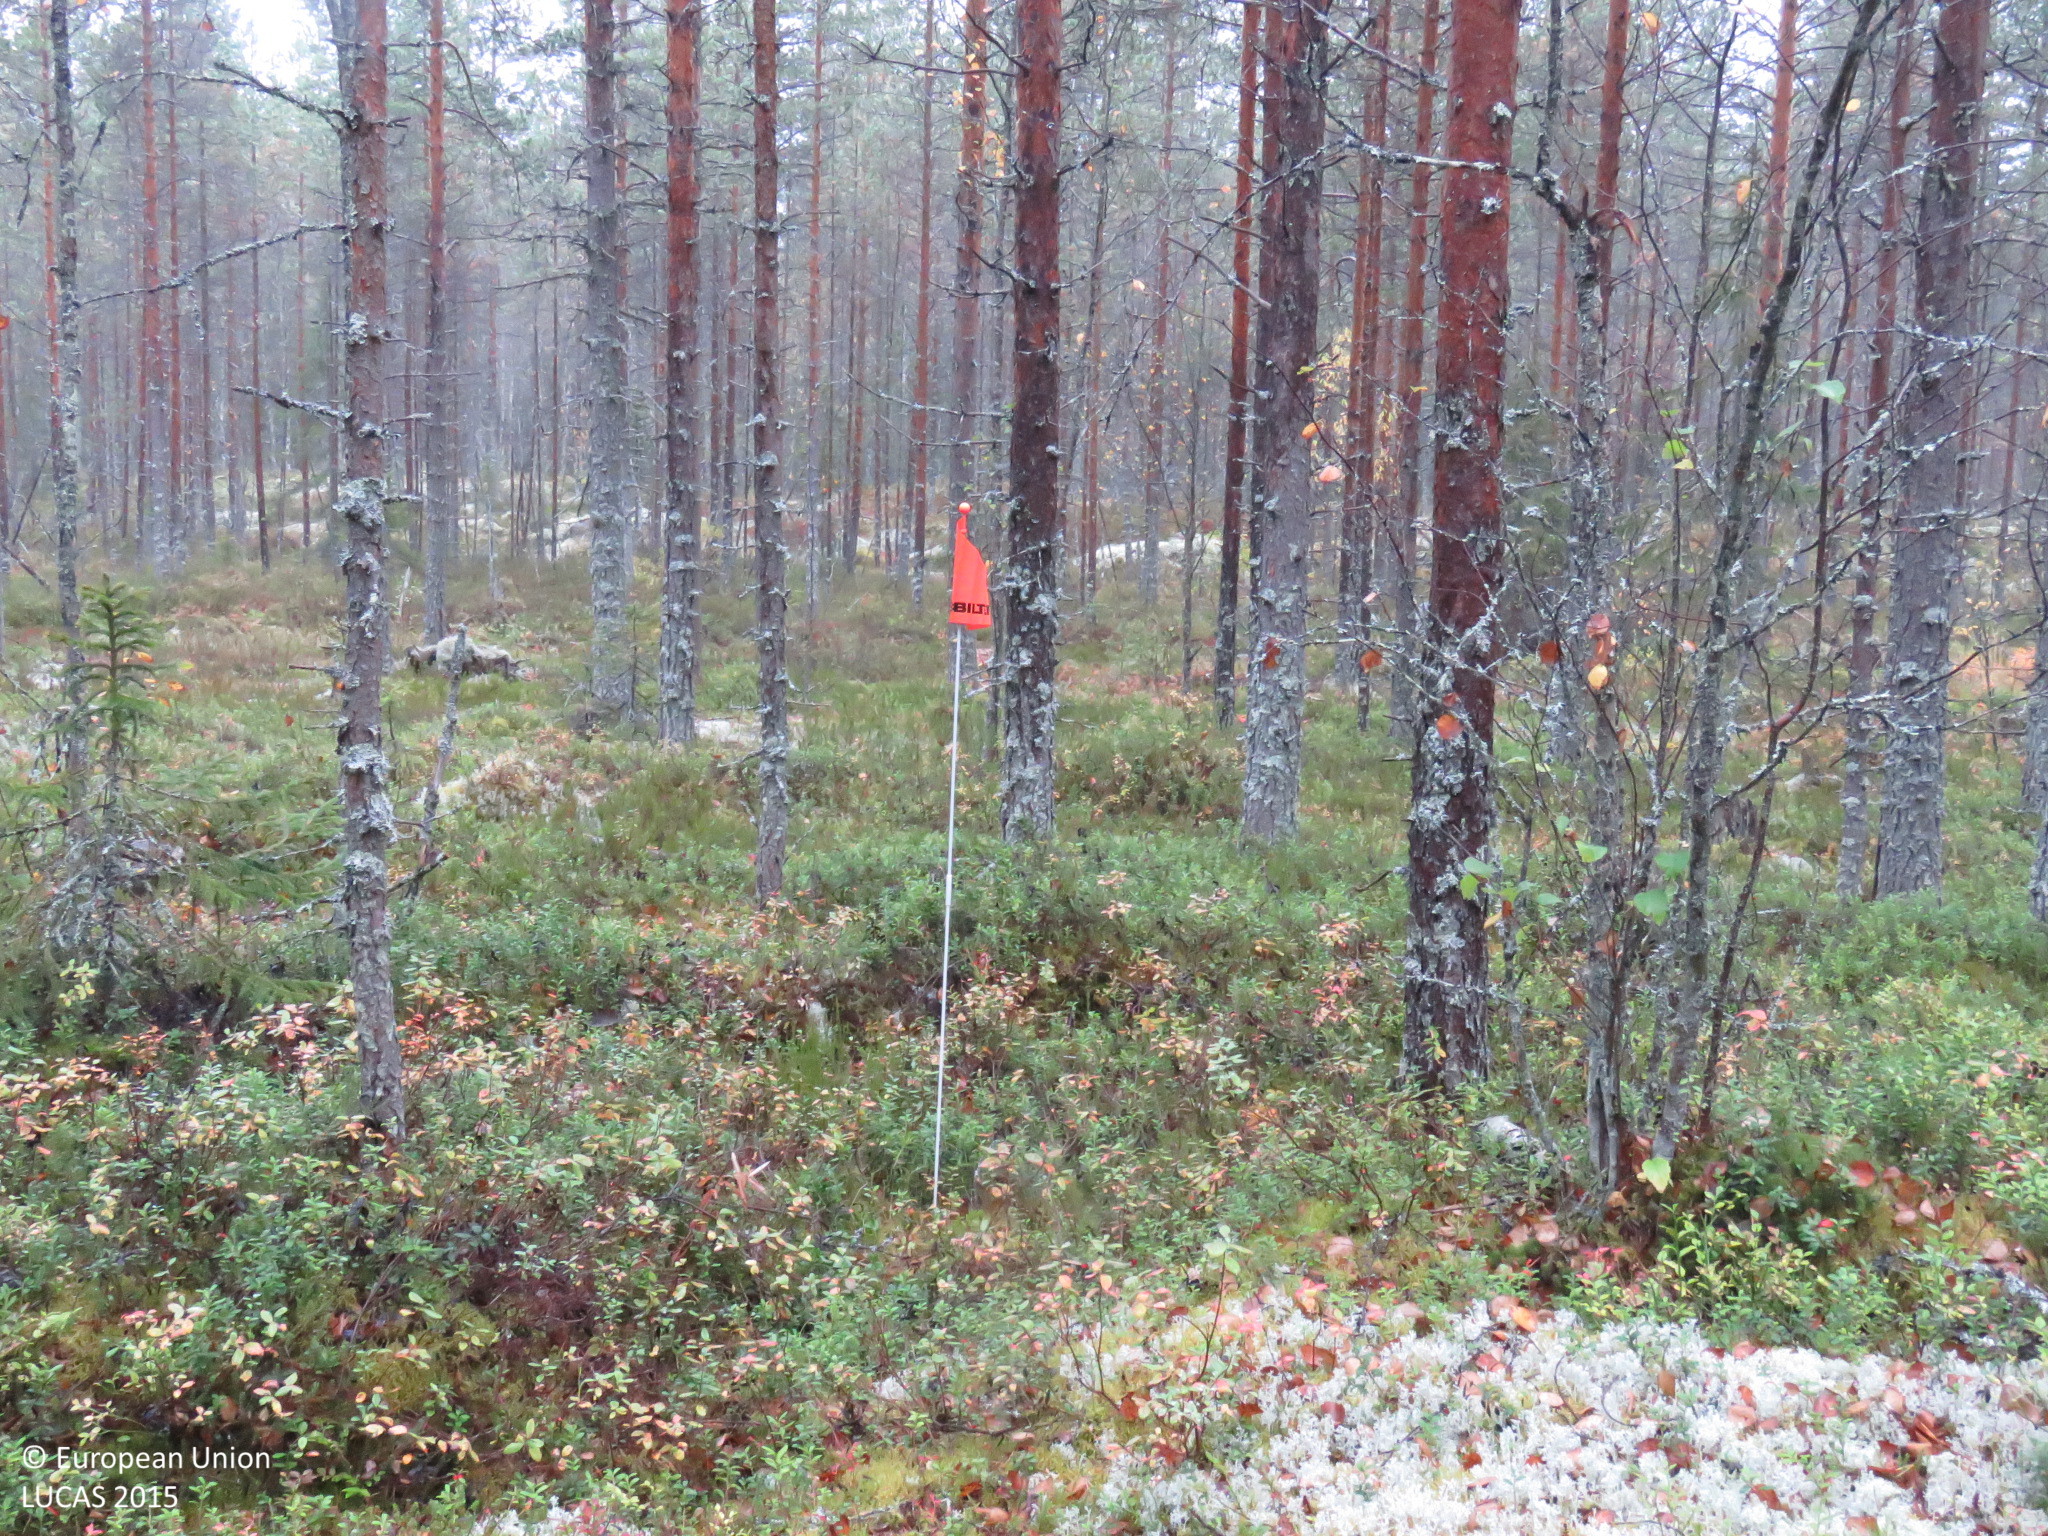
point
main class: Woodland
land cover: Pine dominated coniferous woodland
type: boreal forest
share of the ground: > 75 %
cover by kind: coniferous forest trees 65 %, shrubs 15 %, broadleaved forest trees 10 %, lichens and mosses 10 %
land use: Forestry
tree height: > 5 m
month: September
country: FI
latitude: 64.8221
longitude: 26.8684
